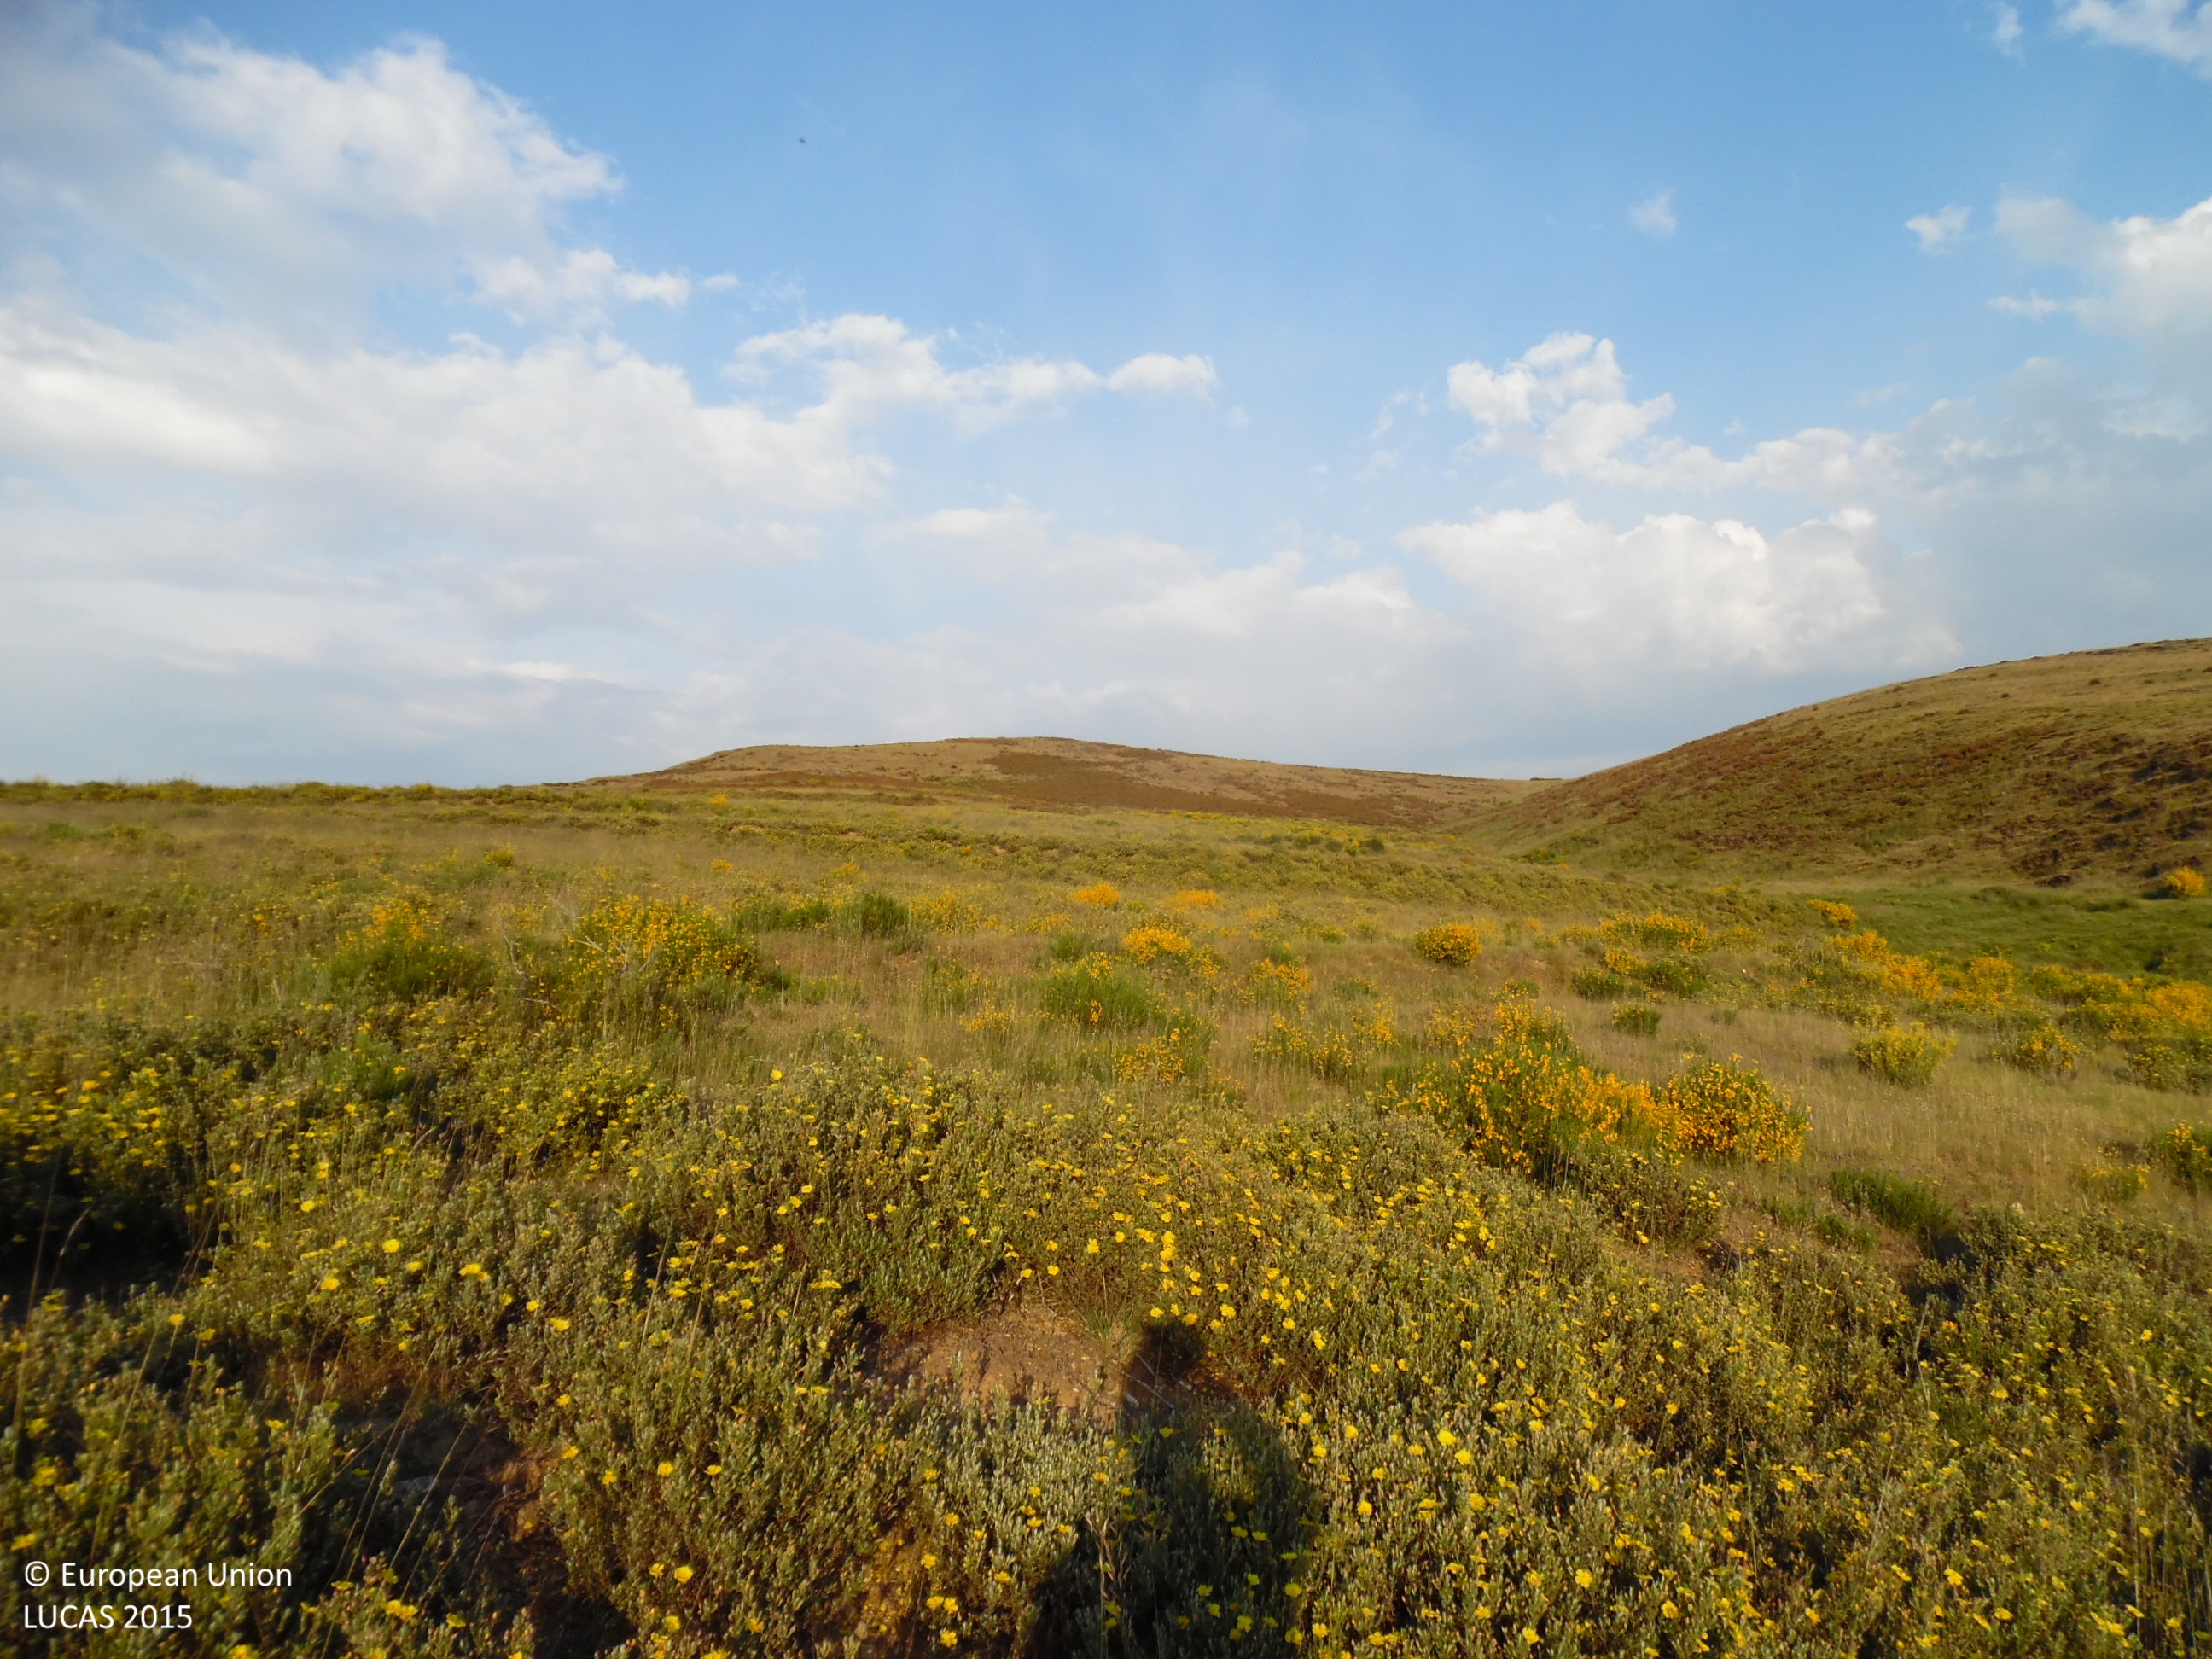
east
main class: Shrubland
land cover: Shrubland without tree cover
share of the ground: > 75 %
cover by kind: shrubs 95 %, herbaceous plants 5 %
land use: Agriculture (excluding fallow land and kitchen gardens)
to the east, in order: Shrubland without tree cover; Artificial constructions; Grassland without tree/shrub cover; Artificial constructions; Shrubland without tree cover; Artificial constructions; Shrubland without tree cover; Artificial constructions; Grassland without tree/shrub cover
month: June
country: ES
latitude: 42.2700
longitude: -6.4683
